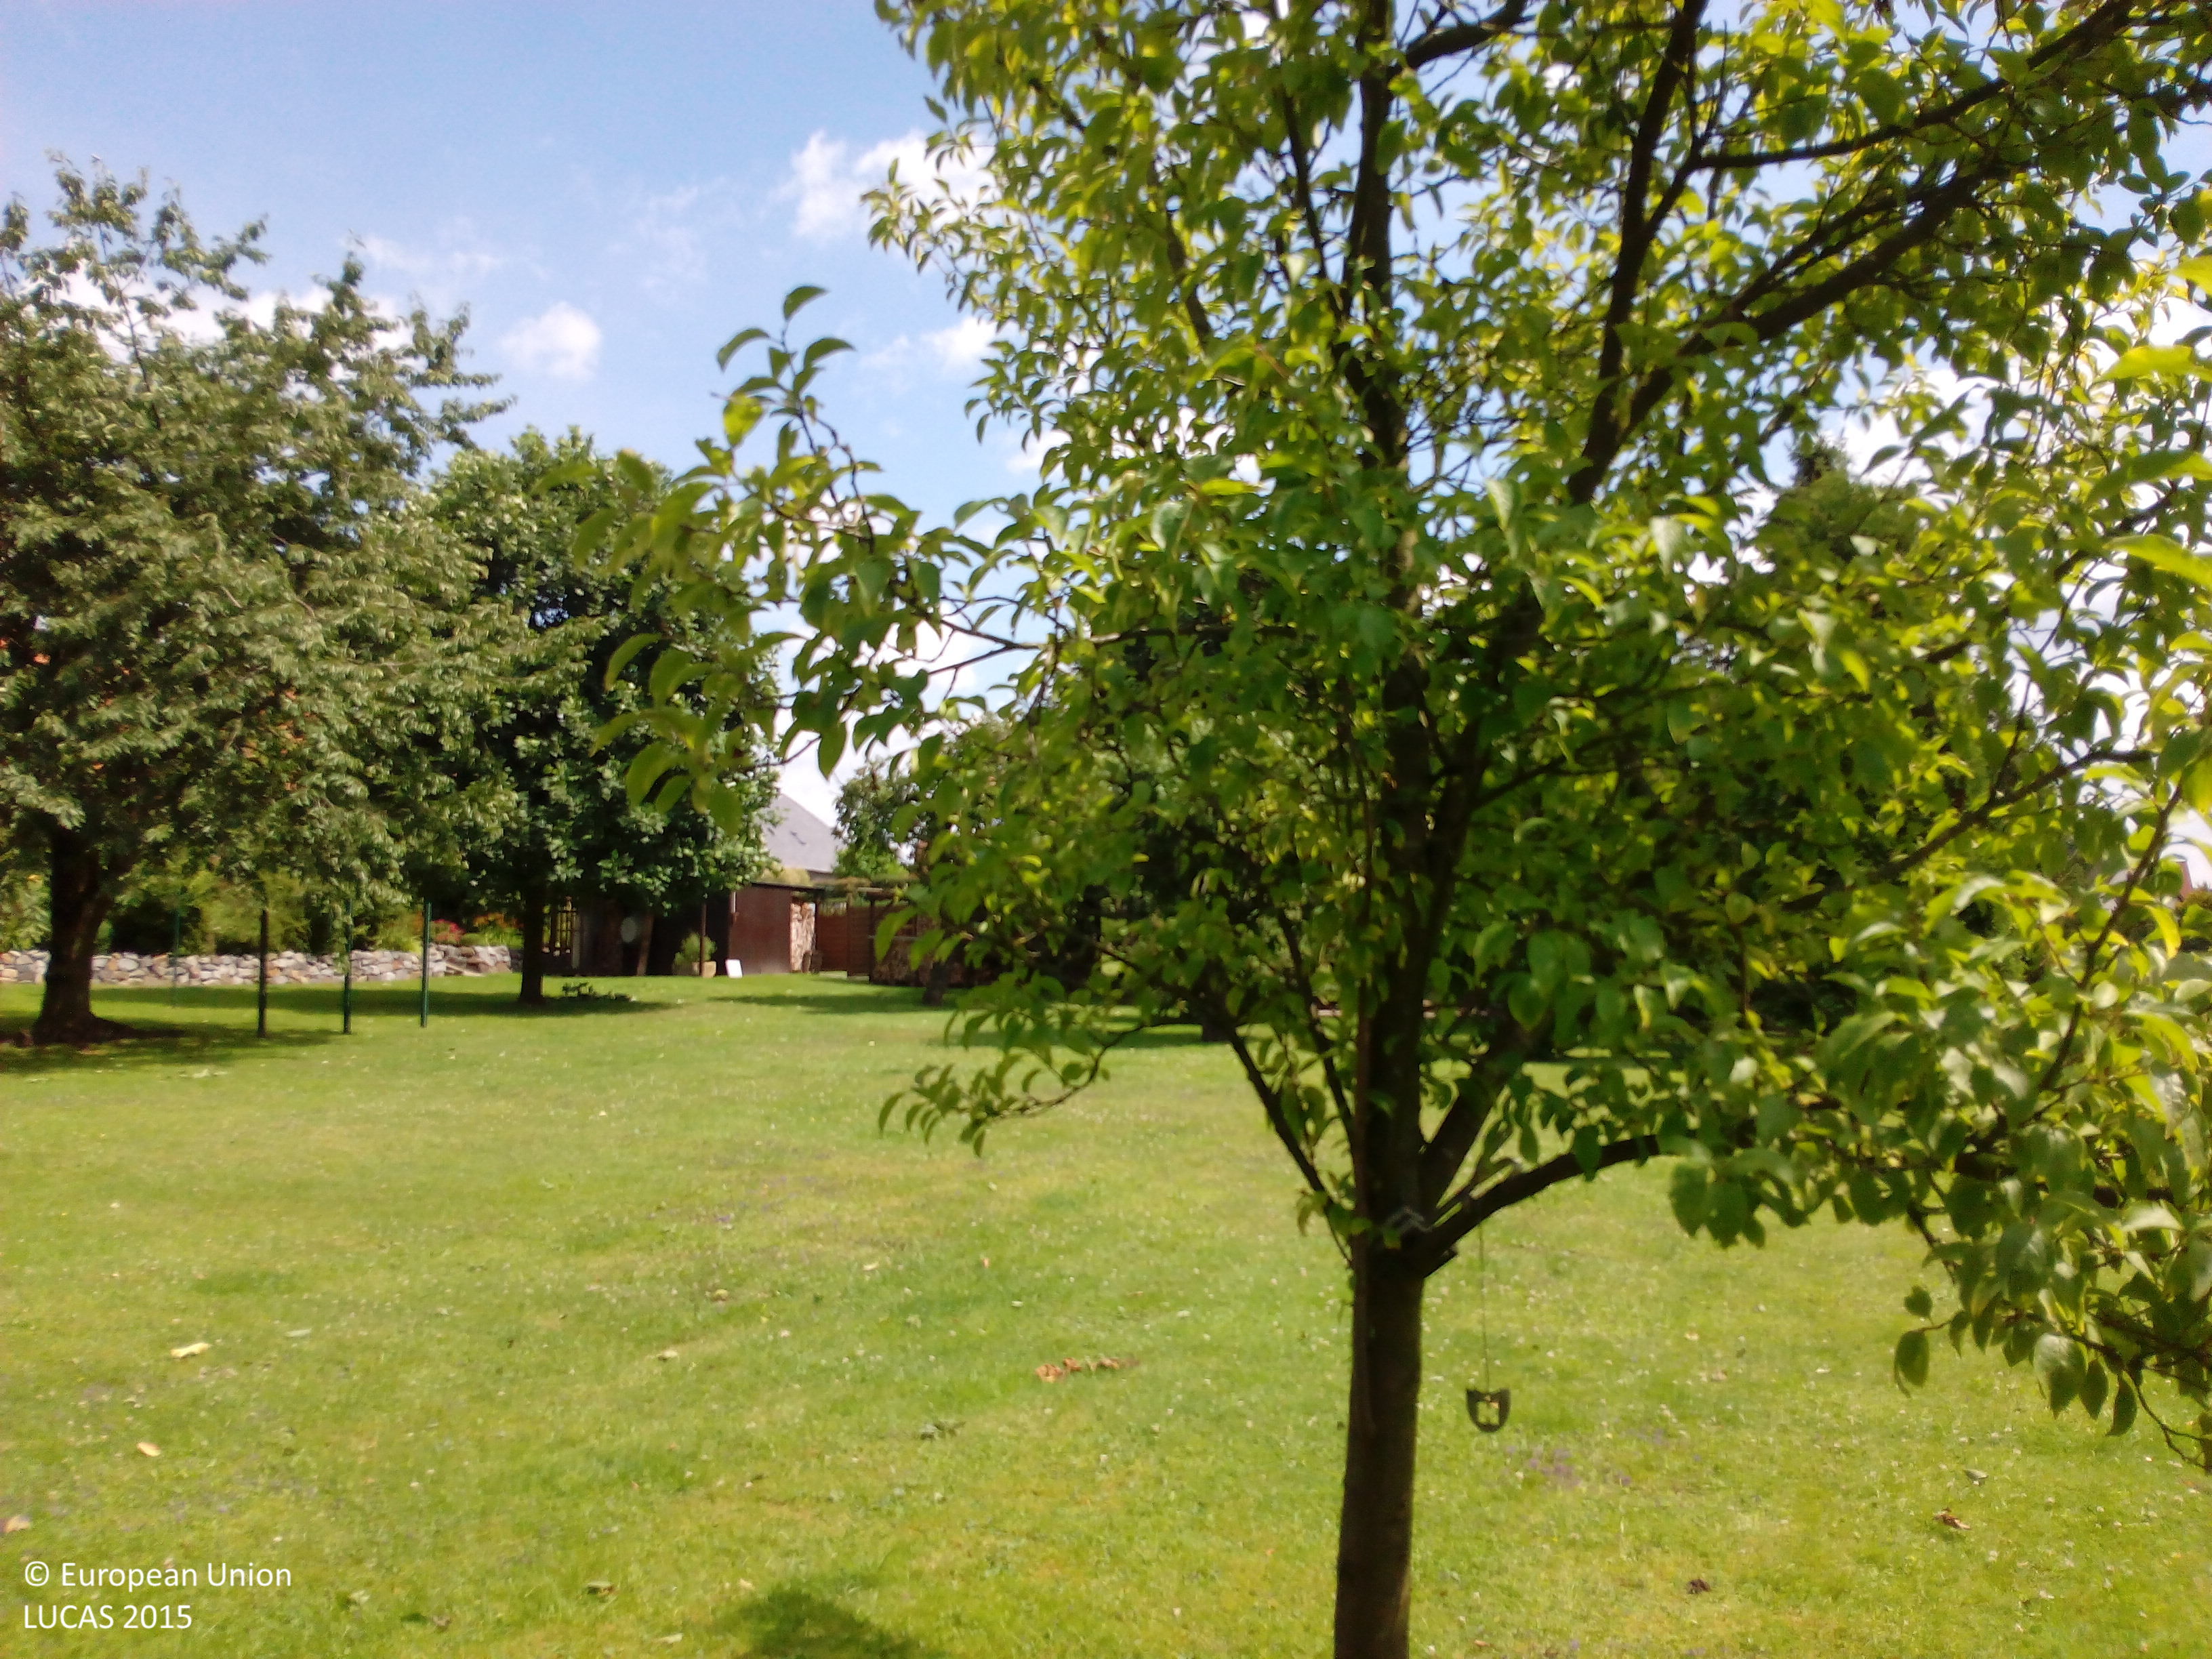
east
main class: Grassland
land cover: Grassland with sparse tree/shrub cover
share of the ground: > 75 %
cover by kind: herbaceous plants 95 %, broadleaved forest trees 5 %
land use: Residential
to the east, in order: Grassland with sparse tree/shrub cover; Artificial constructions in urban areas
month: July
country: DE
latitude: 52.1983
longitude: 7.9668
